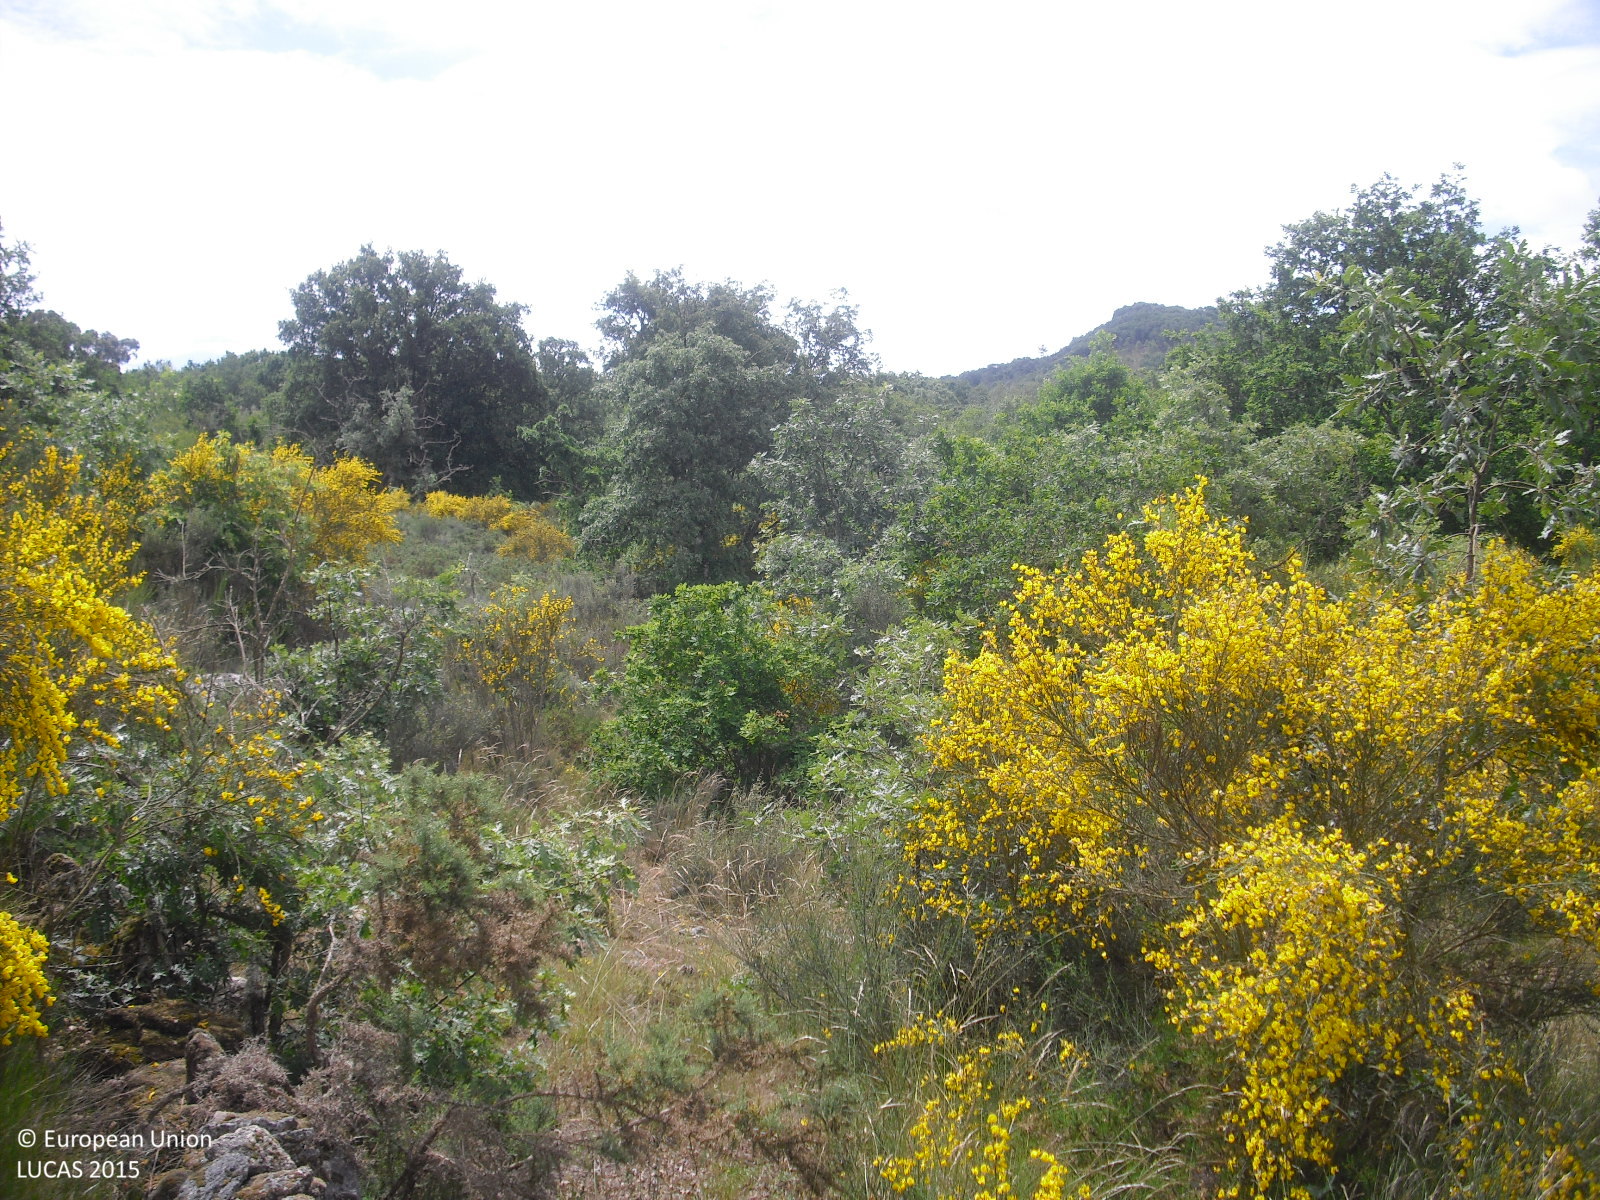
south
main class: Woodland
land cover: Pine dominated mixed woodland
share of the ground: 50 - 75 %
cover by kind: coniferous forest trees 50 %, shrubs 30 %, broadleaved forest trees 20 %
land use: Forestry
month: May
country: ES
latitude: 42.1553
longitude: -7.8774
